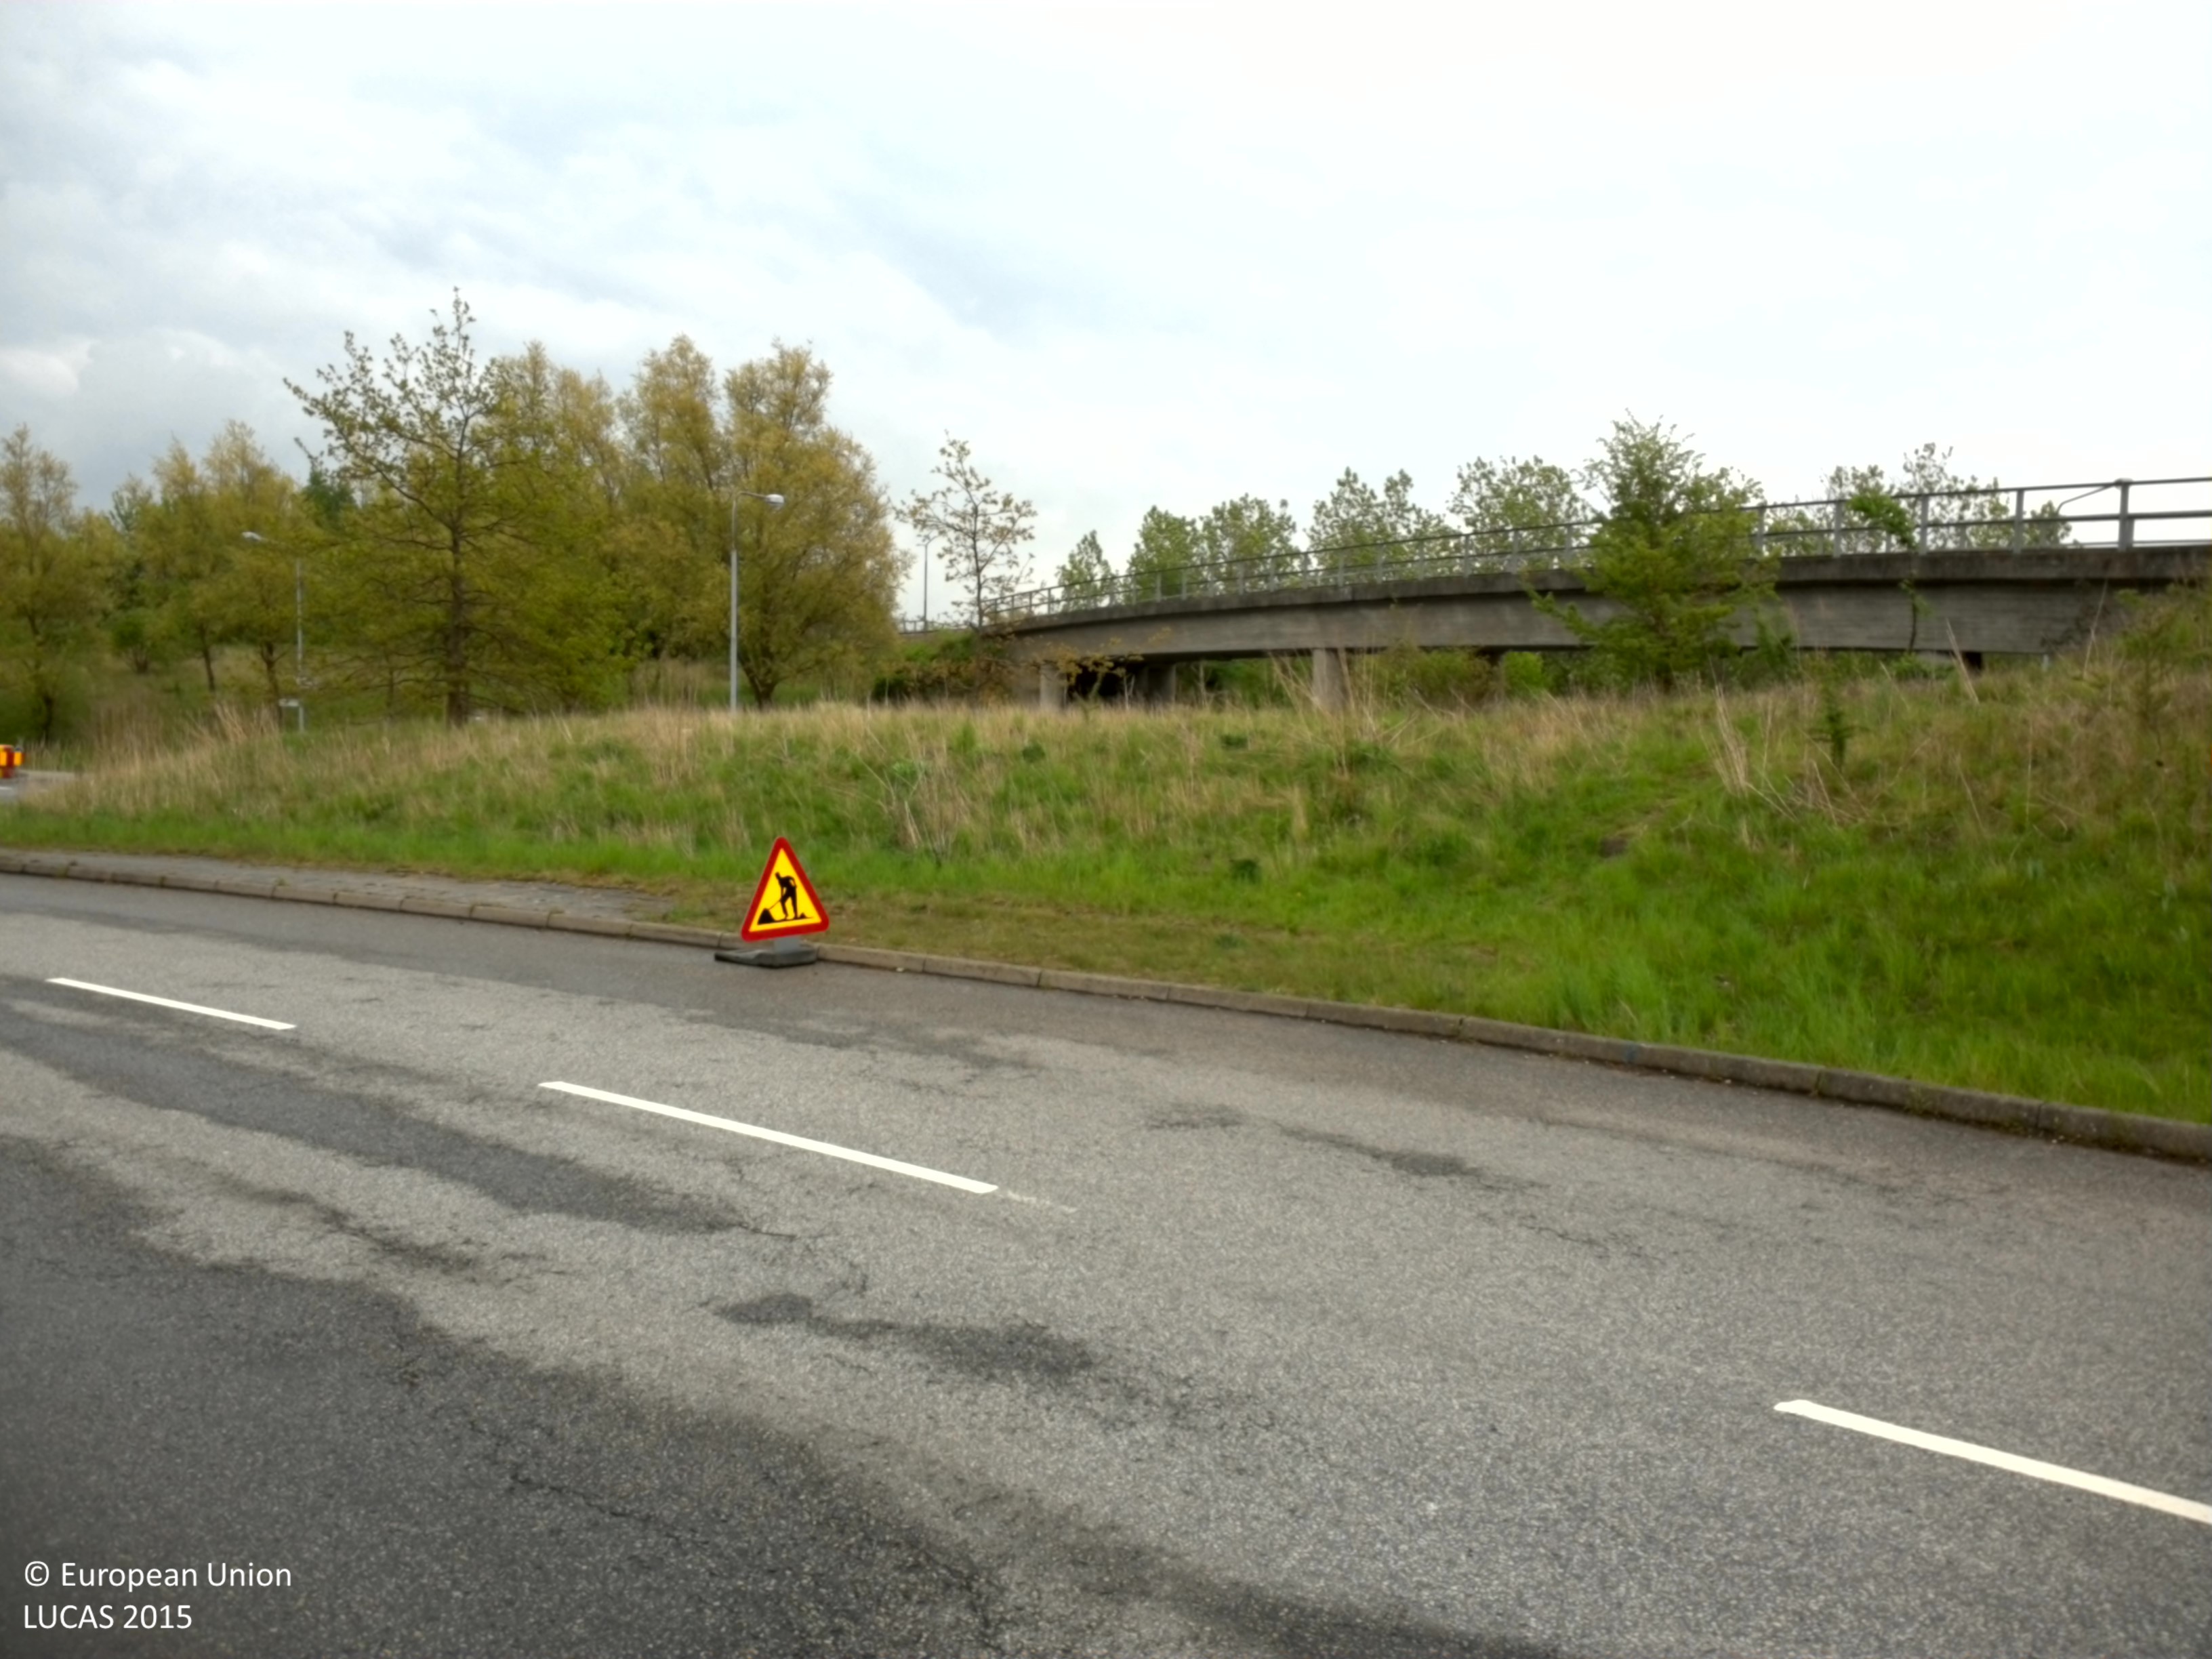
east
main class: Grassland
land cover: Grassland without tree/shrub cover
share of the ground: > 75 %
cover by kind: herbaceous plants 100 %
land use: Road transport
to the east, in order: Grassland without tree/shrub cover; Paved roads, cycling and walking lanes; Grassland without tree/shrub cover; Paved roads, cycling and walking lanes; Broadleaved woodland; Paved roads, cycling and walking lanes; Grassland without tree/shrub cover; Paved roads, cycling and walking lanes; Grassland without tree/shrub cover; Paved roads, cycling and walking lanes; Grassland without tree/shrub cover
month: May
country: SE
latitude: 55.6116
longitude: 13.0620
